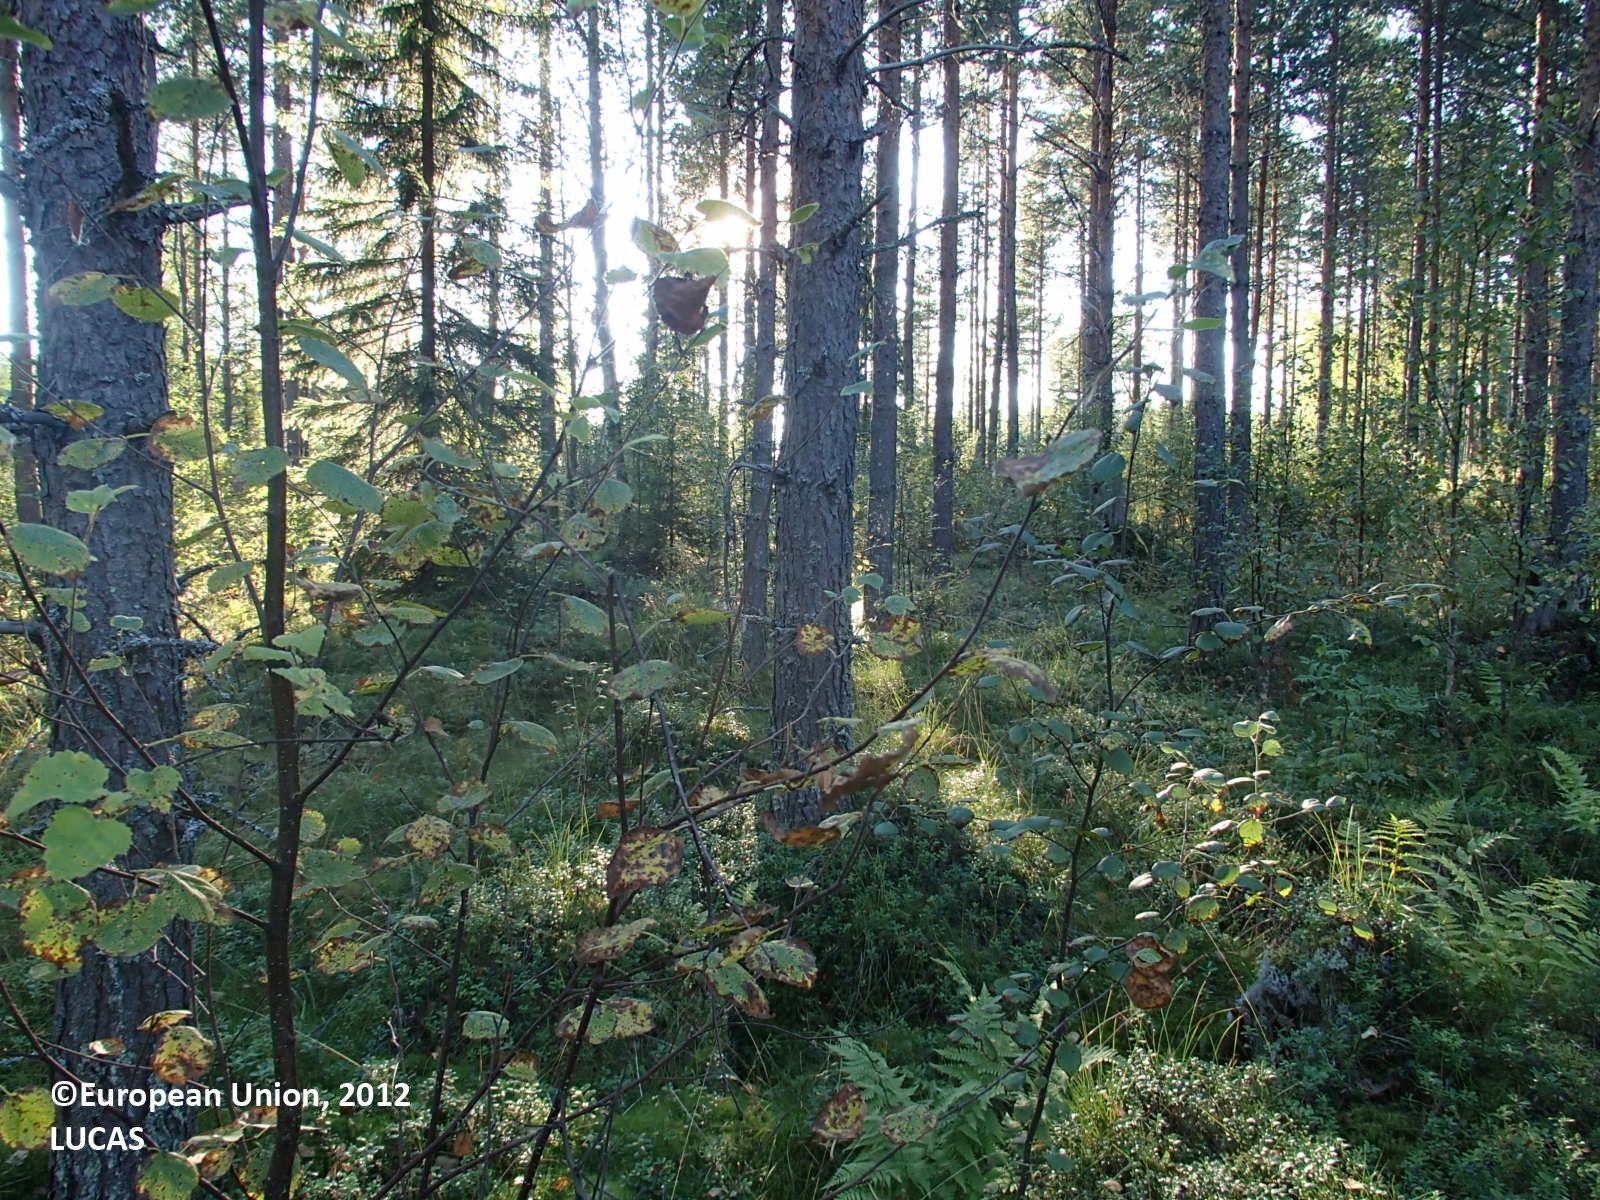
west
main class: Woodland
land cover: Pine dominated mixed woodland
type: boreal forest
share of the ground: 50 - 75 %
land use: Forestry
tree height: > 5 m
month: August
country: FI
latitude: 63.4999
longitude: 28.0311
